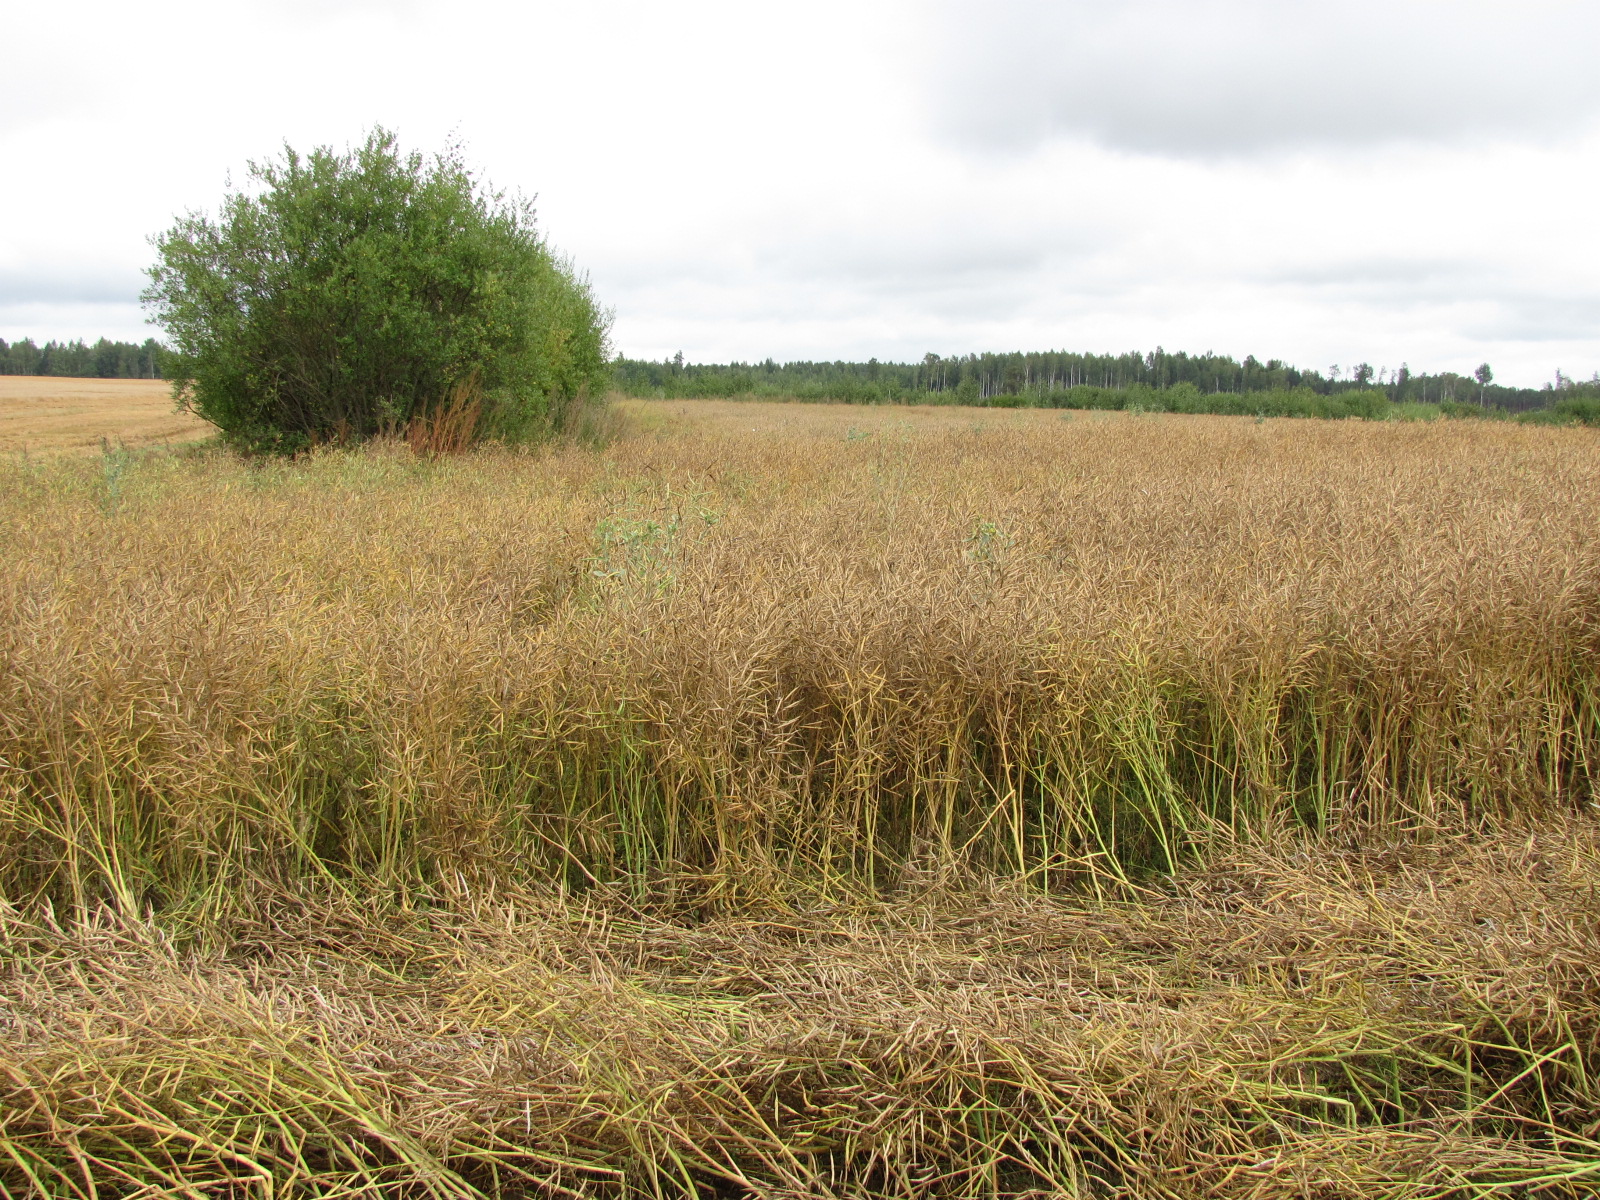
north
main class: Cropland
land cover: Rape and turnip rape
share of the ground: > 75 %
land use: Agriculture (excluding fallow land and kitchen gardens)
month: September
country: LV
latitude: 56.6388
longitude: 25.2942
